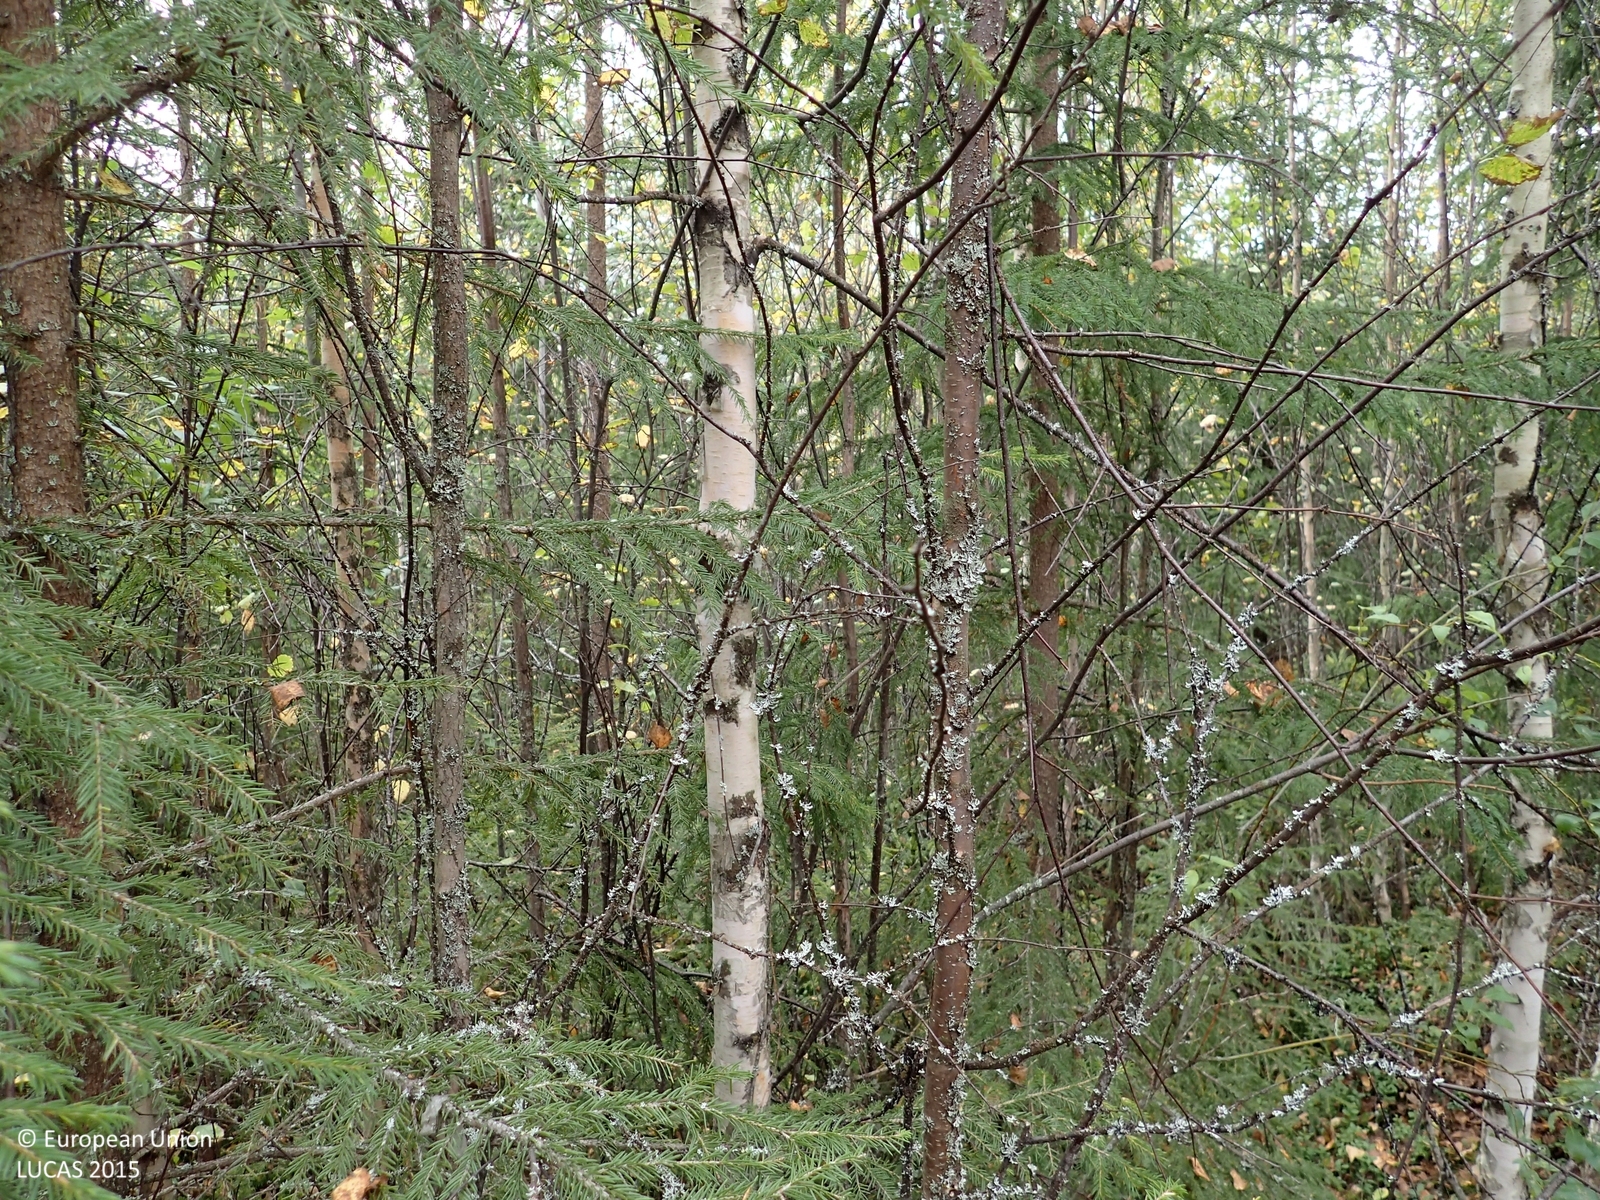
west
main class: Woodland
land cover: Spruce dominated mixed woodland
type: boreal forest
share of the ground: > 75 %
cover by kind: broadleaved forest trees 50 %, coniferous forest trees 35 %, shrubs 5 %, herbaceous plants 5 %, lichens and mosses 5 %
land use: Forestry
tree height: < 5 m
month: September
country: FI
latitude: 62.9199
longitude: 25.9289
